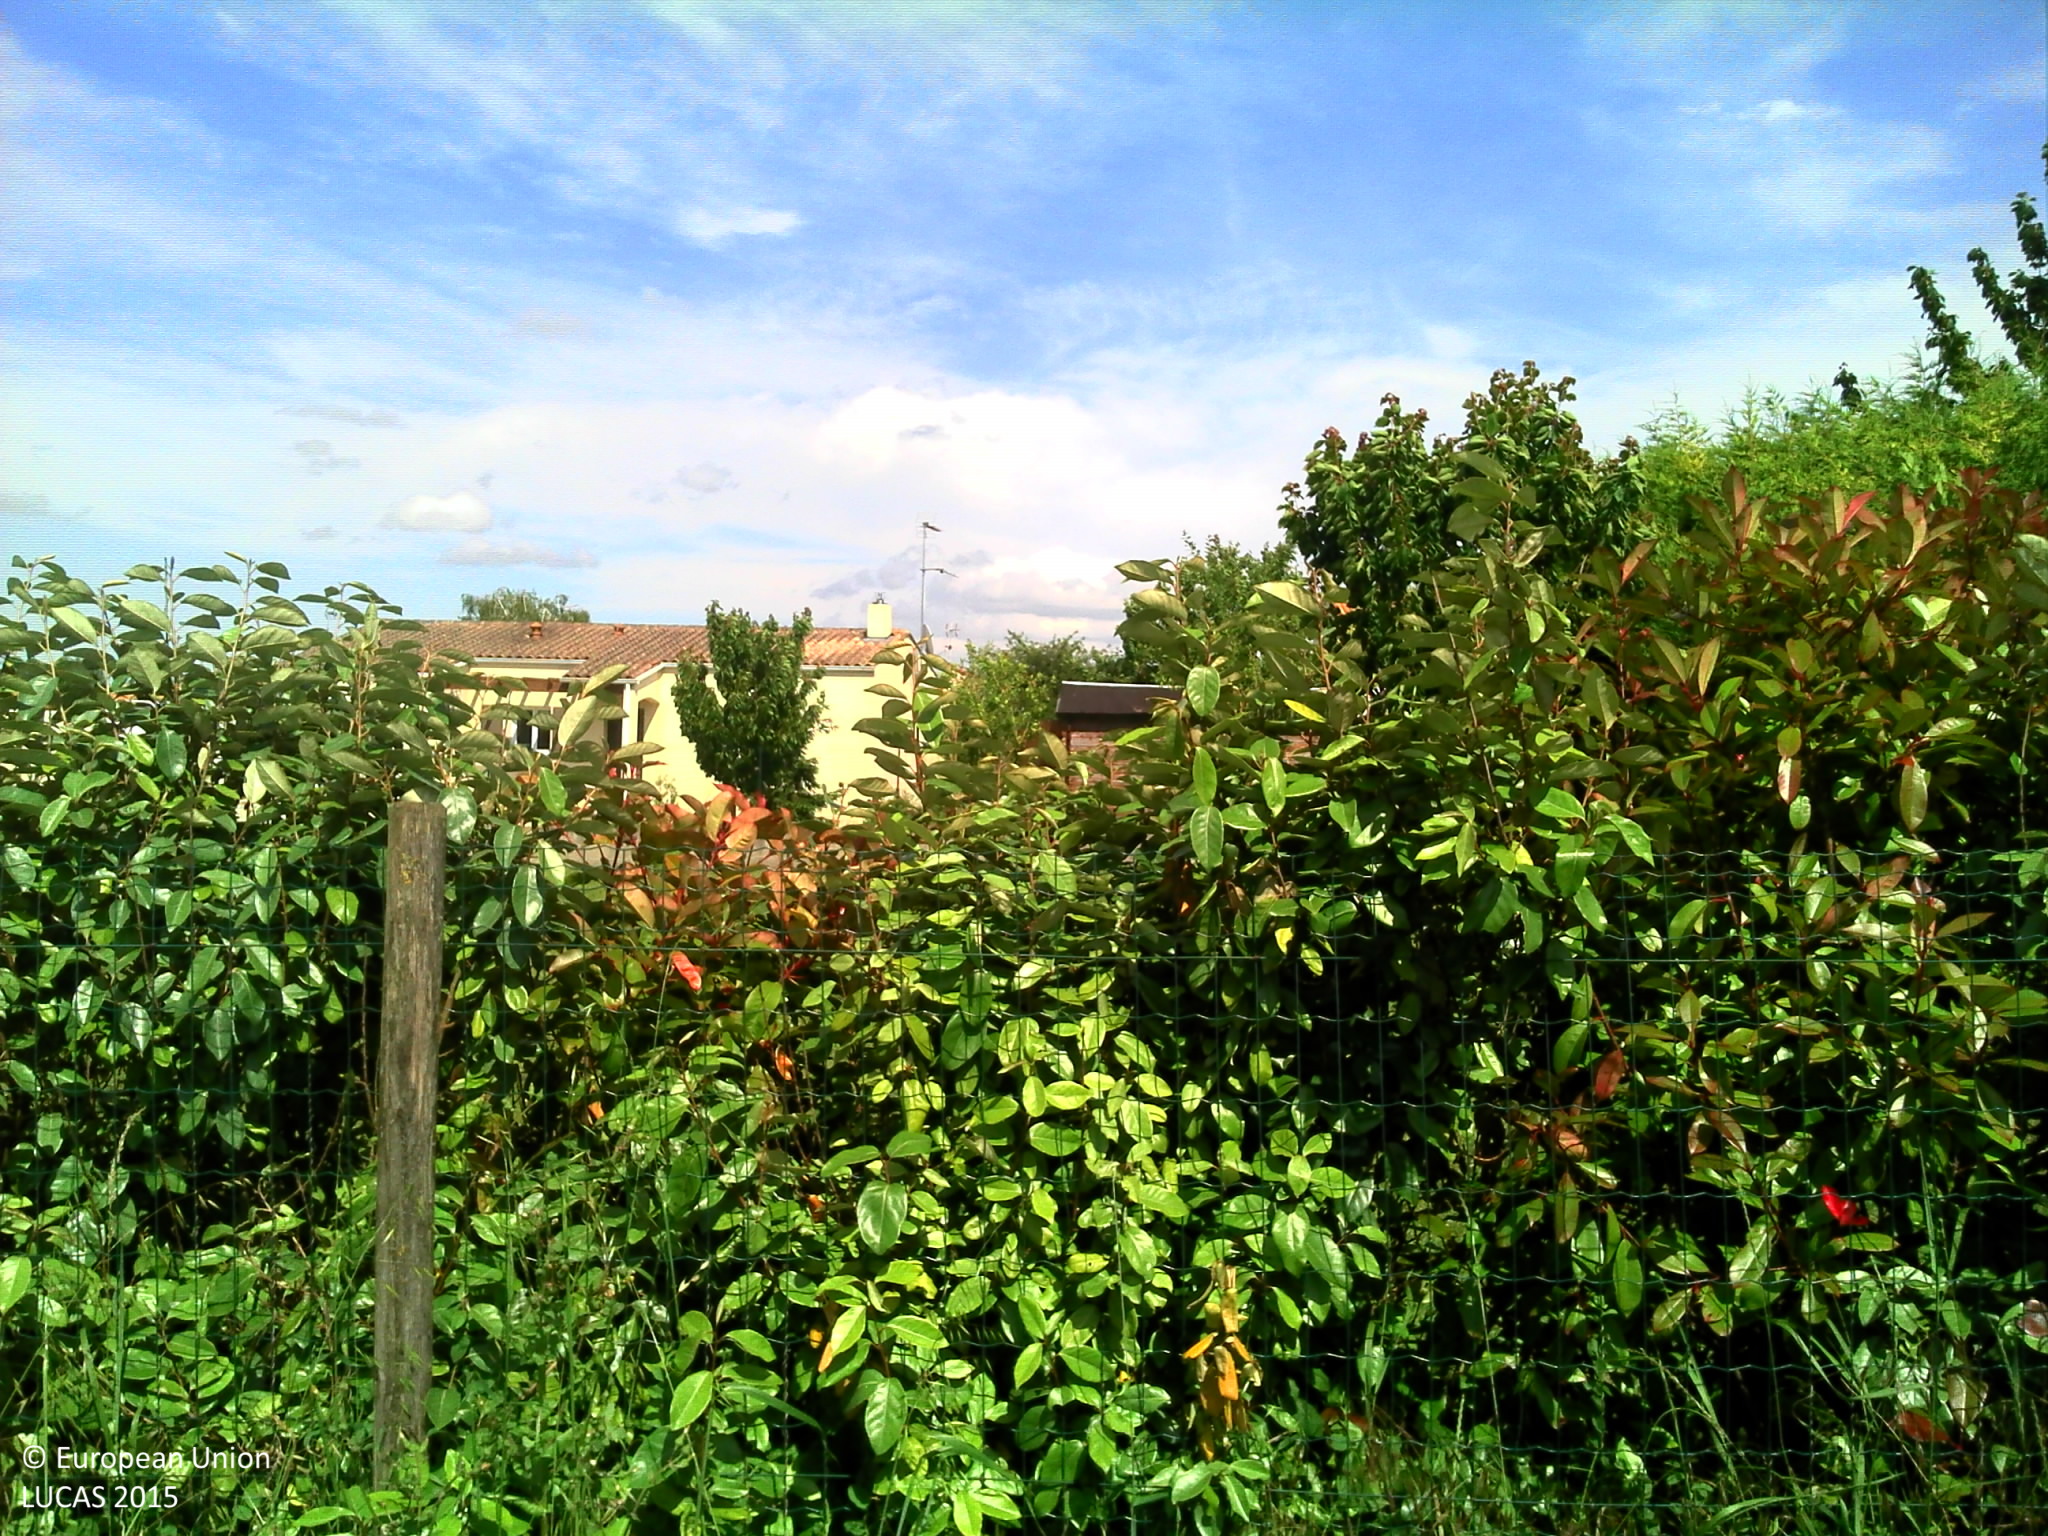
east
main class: Grassland
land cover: Grassland without tree/shrub cover
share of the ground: > 75 %
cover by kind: herbaceous plants 100 %
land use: Residential
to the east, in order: Grassland without tree/shrub cover; Artificial constructions in urban areas
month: June
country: FR
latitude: 46.3087
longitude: -1.0031
